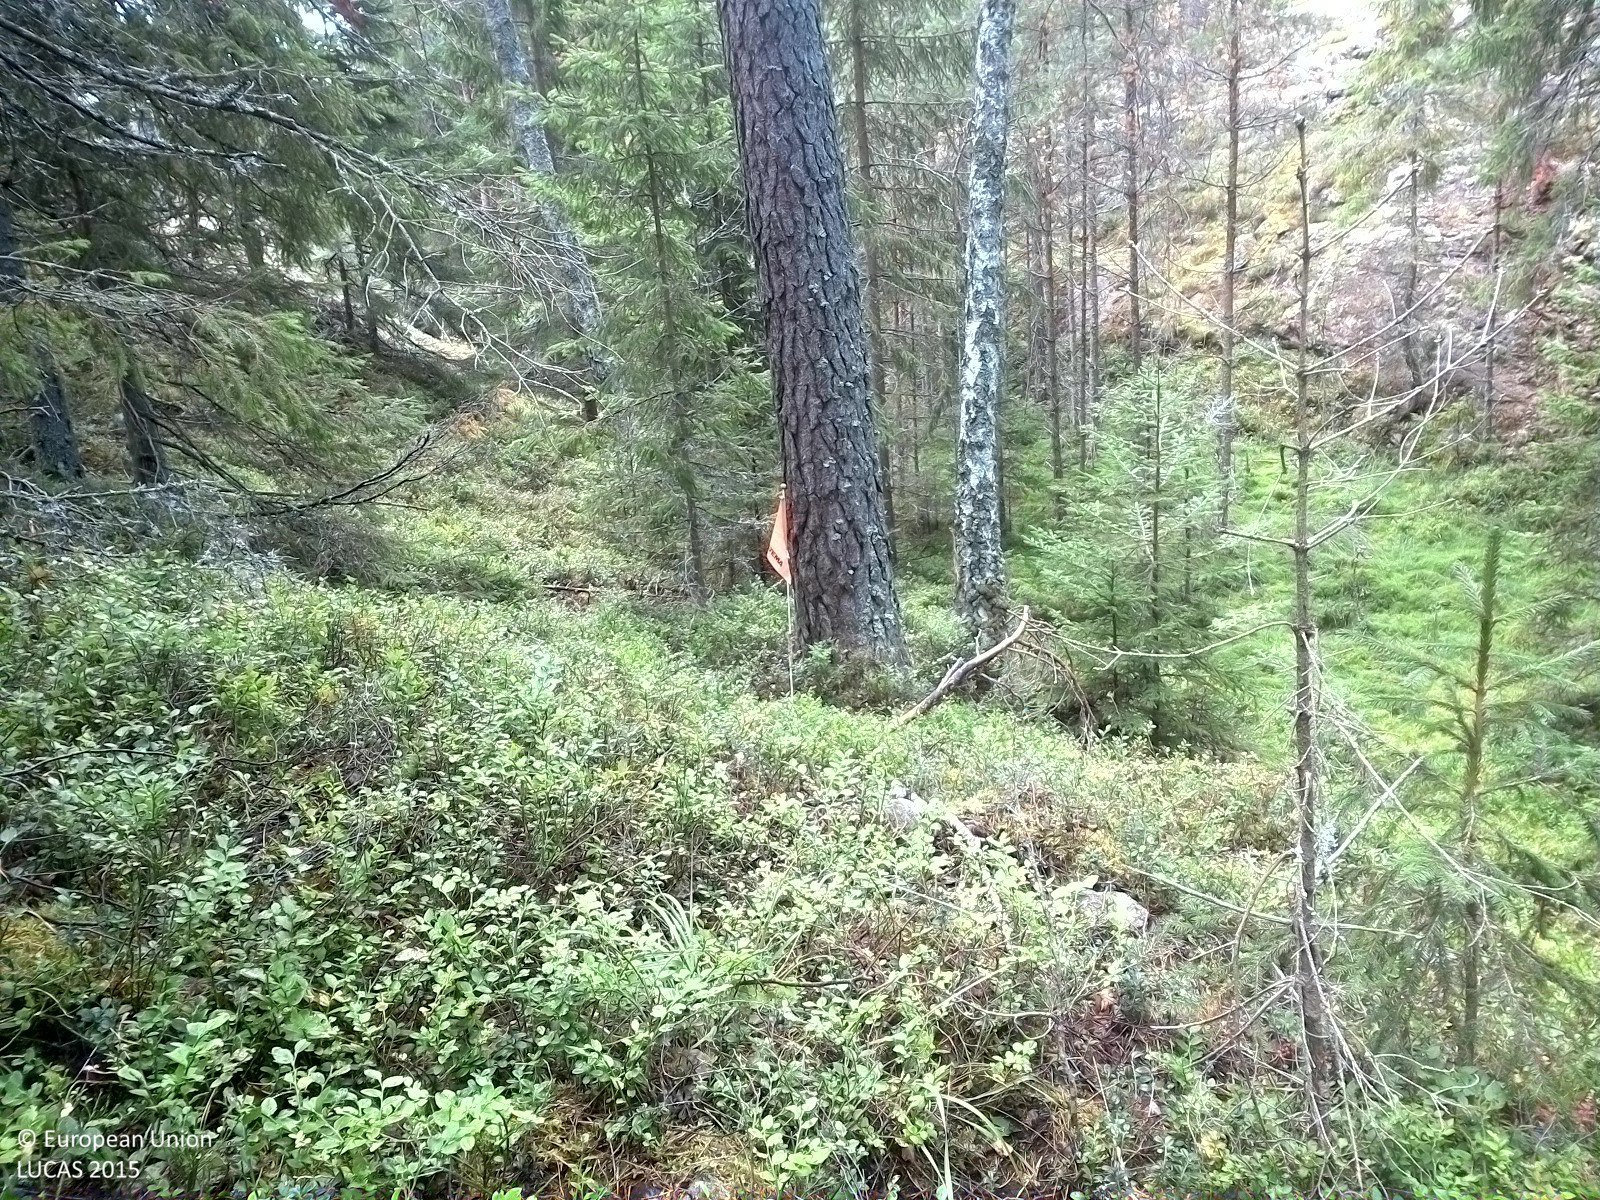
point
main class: Woodland
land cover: Pine dominated mixed woodland
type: boreal forest
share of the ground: 25 - 50 %
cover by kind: herbaceous plants 65 %, coniferous forest trees 20 %, broadleaved forest trees 10 %, lichens and mosses 5 %
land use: Forestry
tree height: > 5 m
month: August
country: SE
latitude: 58.9739
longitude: 15.4719
